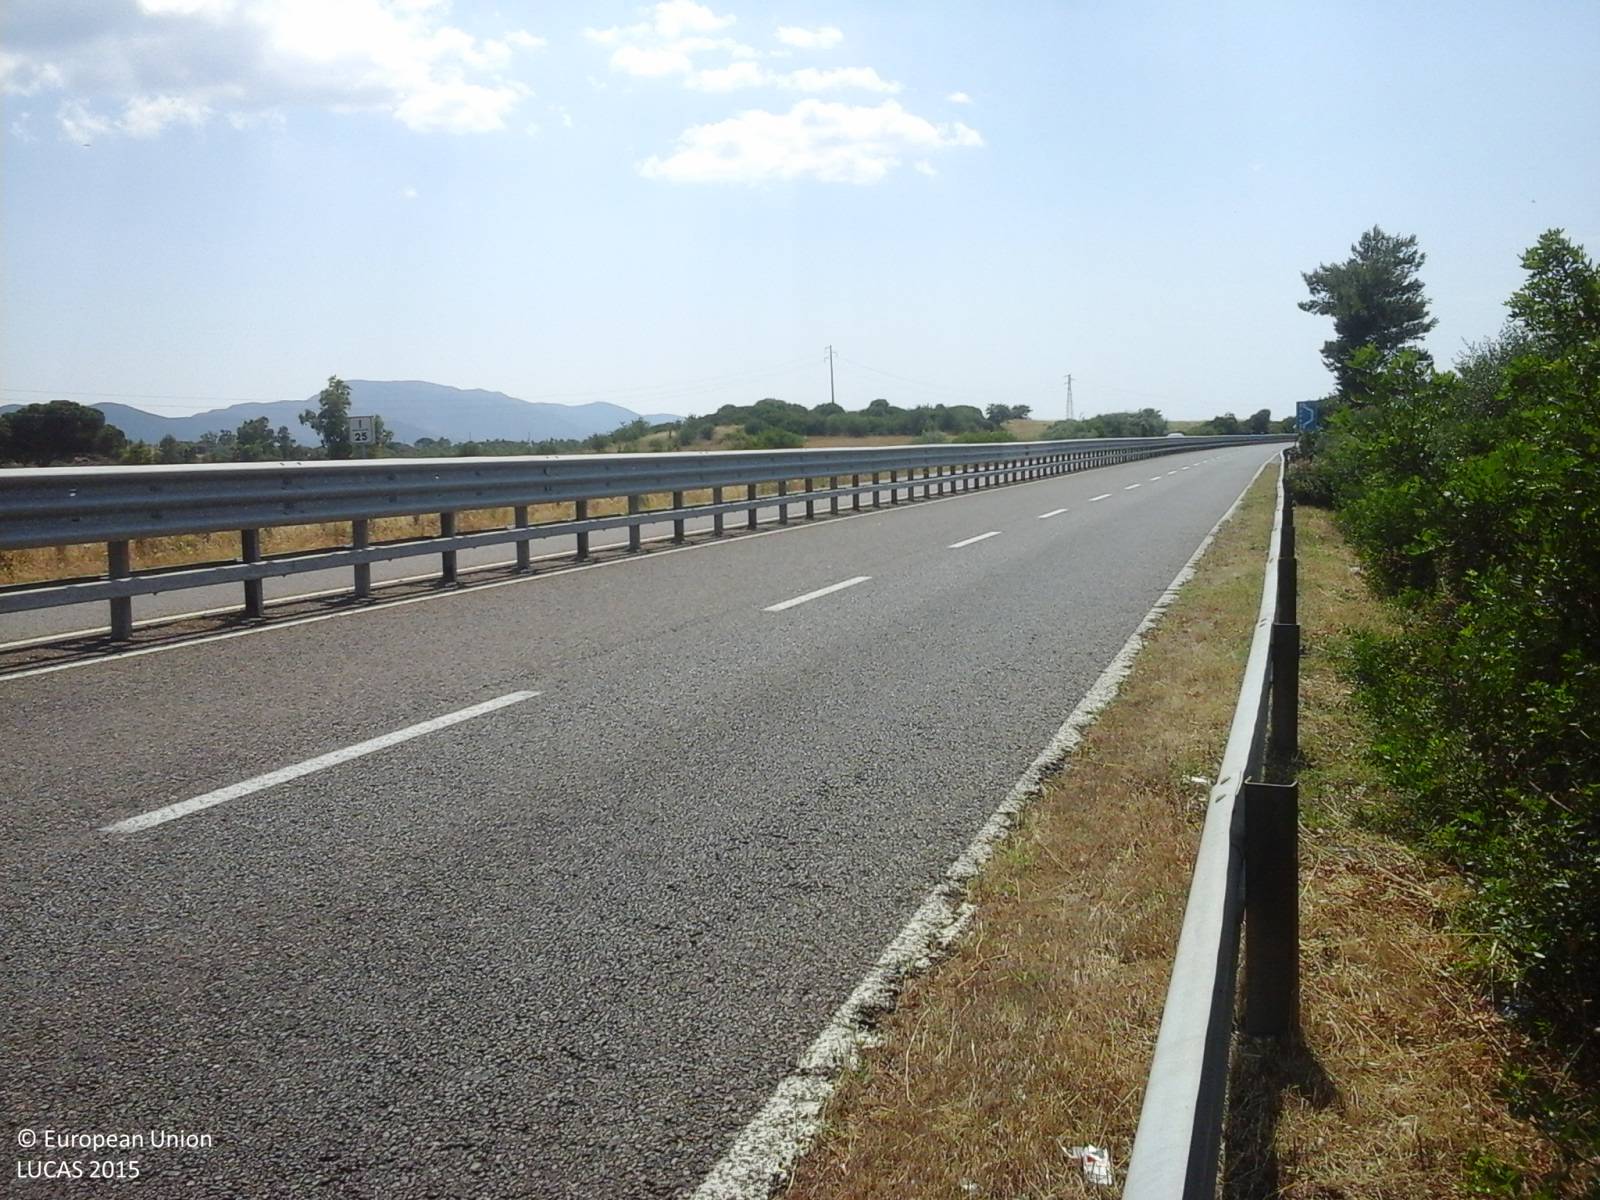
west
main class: Shrubland
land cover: Shrubland without tree cover
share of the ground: > 75 %
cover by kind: herbaceous plants 60 %, shrubs 40 %
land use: Road transport
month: June
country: IT
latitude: 39.3007
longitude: 8.8590
